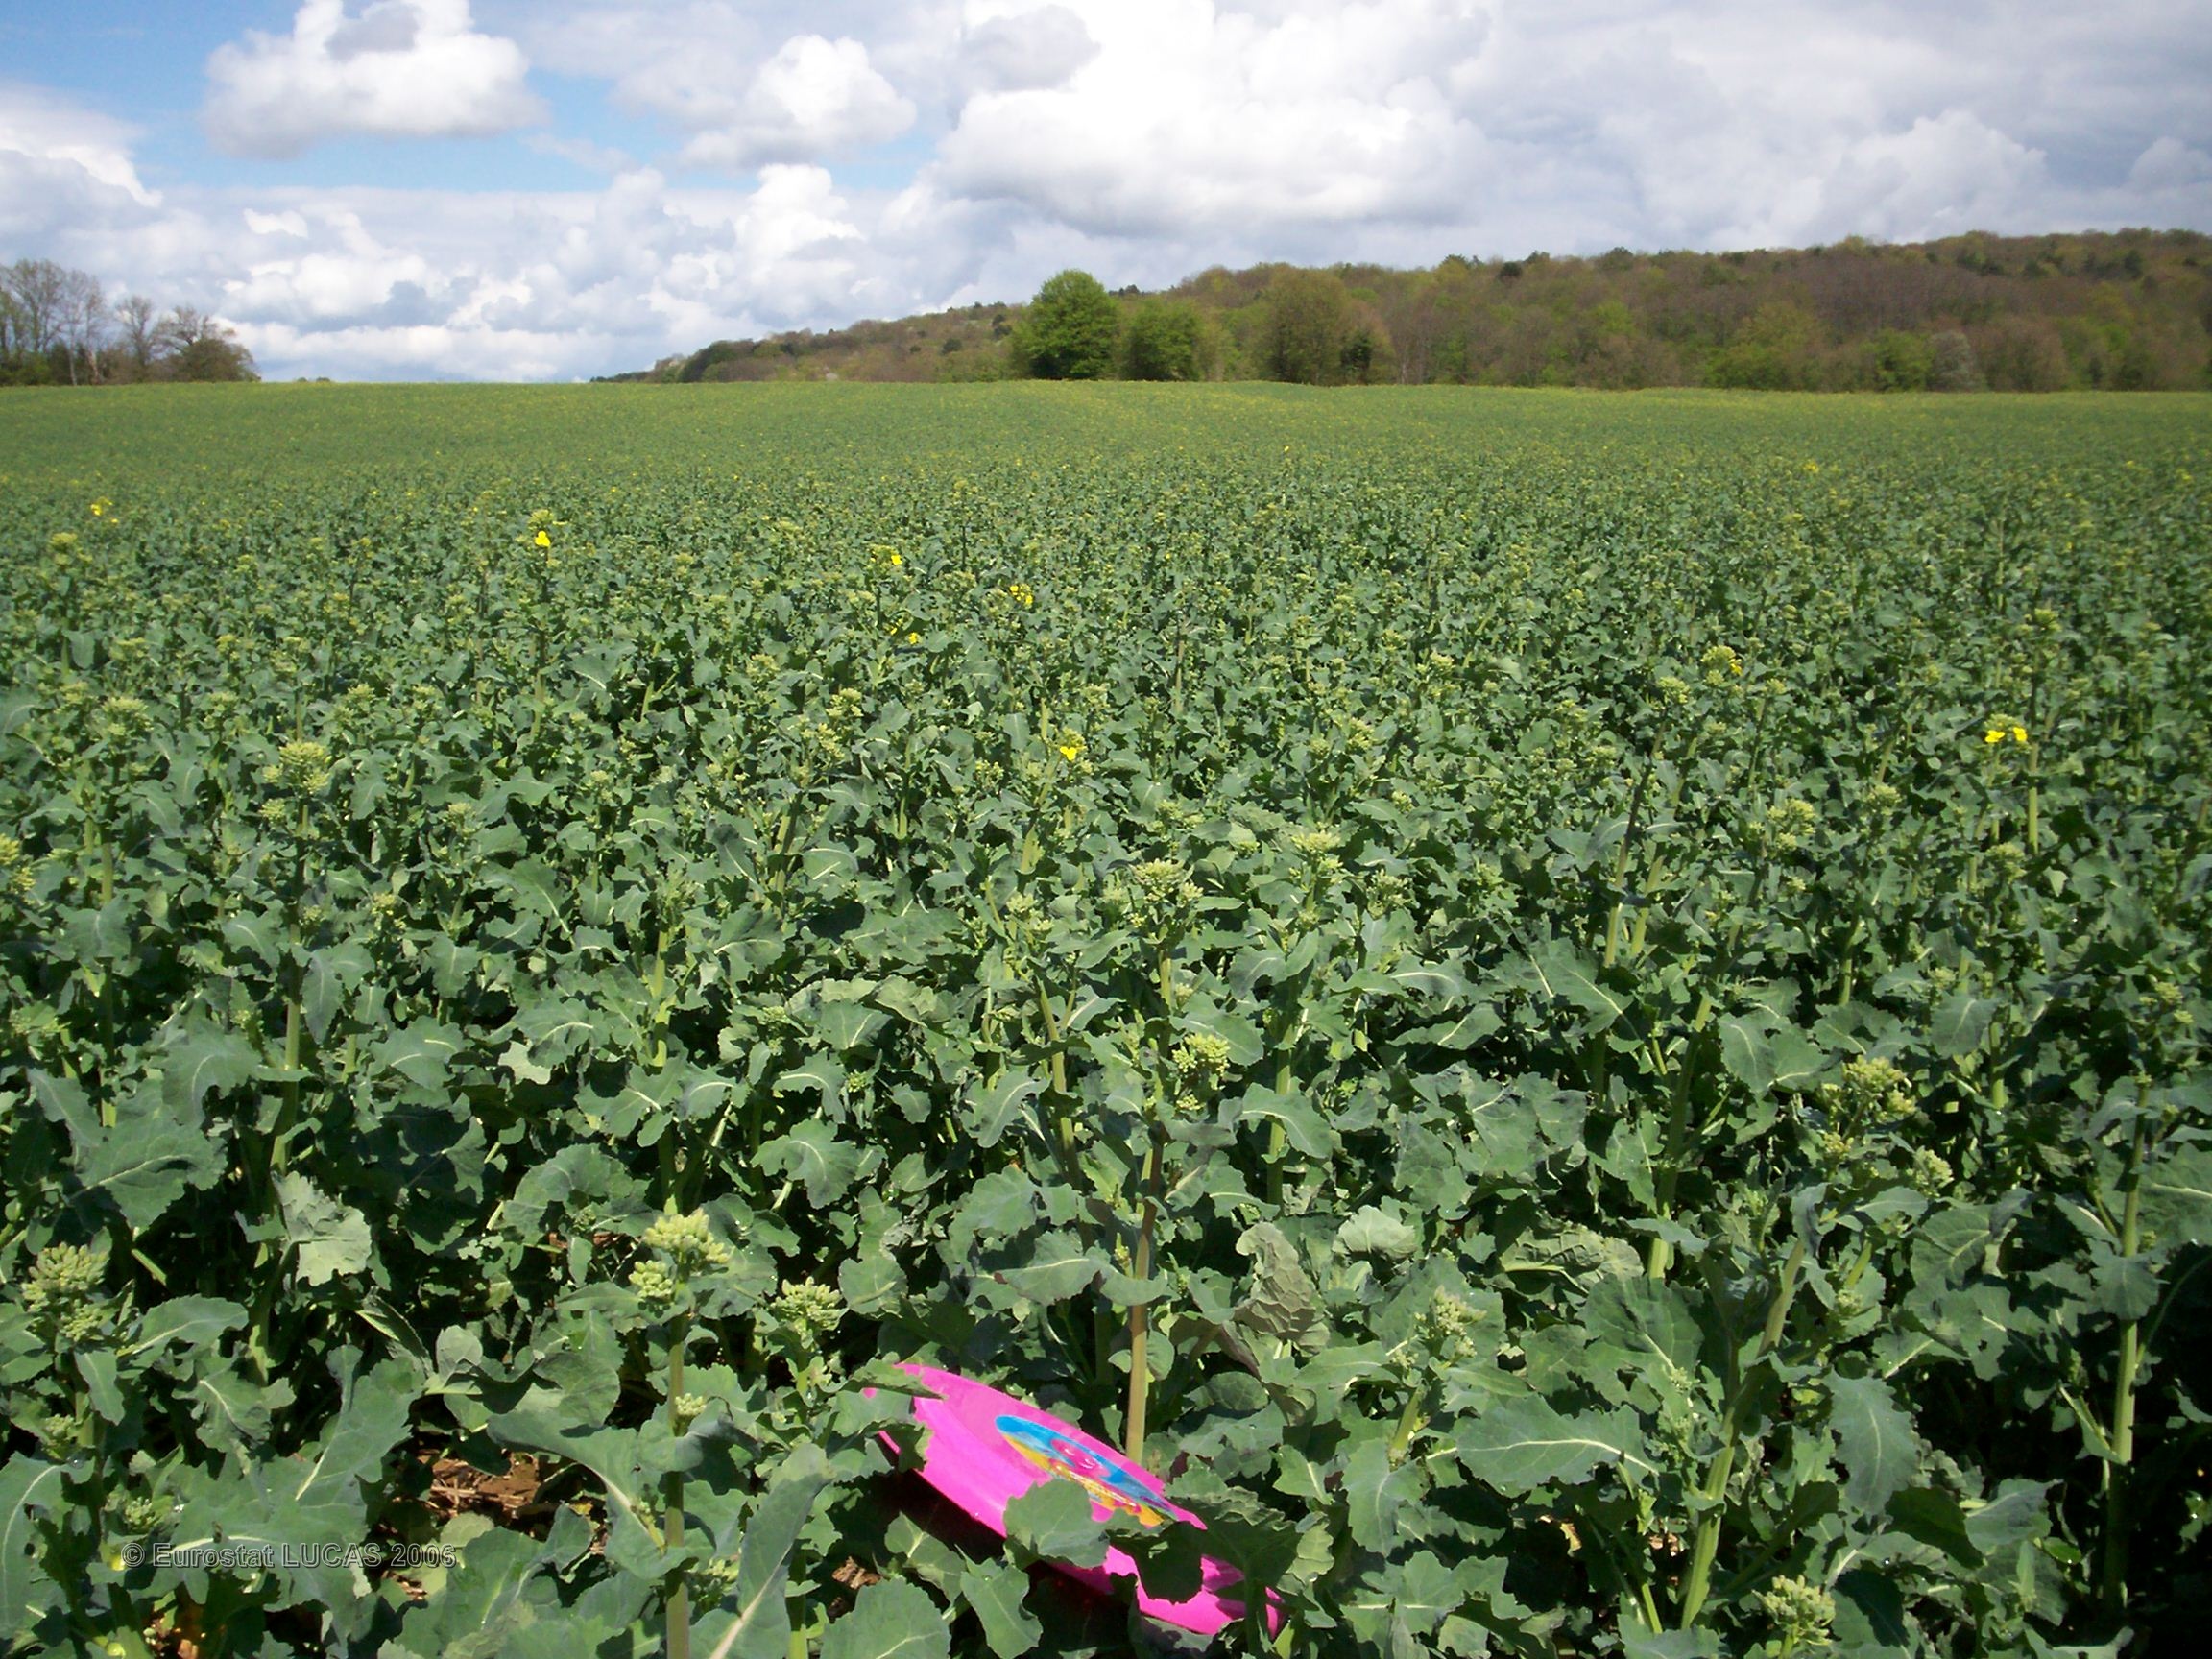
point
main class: Cropland
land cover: Rape and turnip rape
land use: Agriculture (excluding fallow land and kitchen gardens)
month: April
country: FR
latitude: 47.5413
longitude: 6.0821
